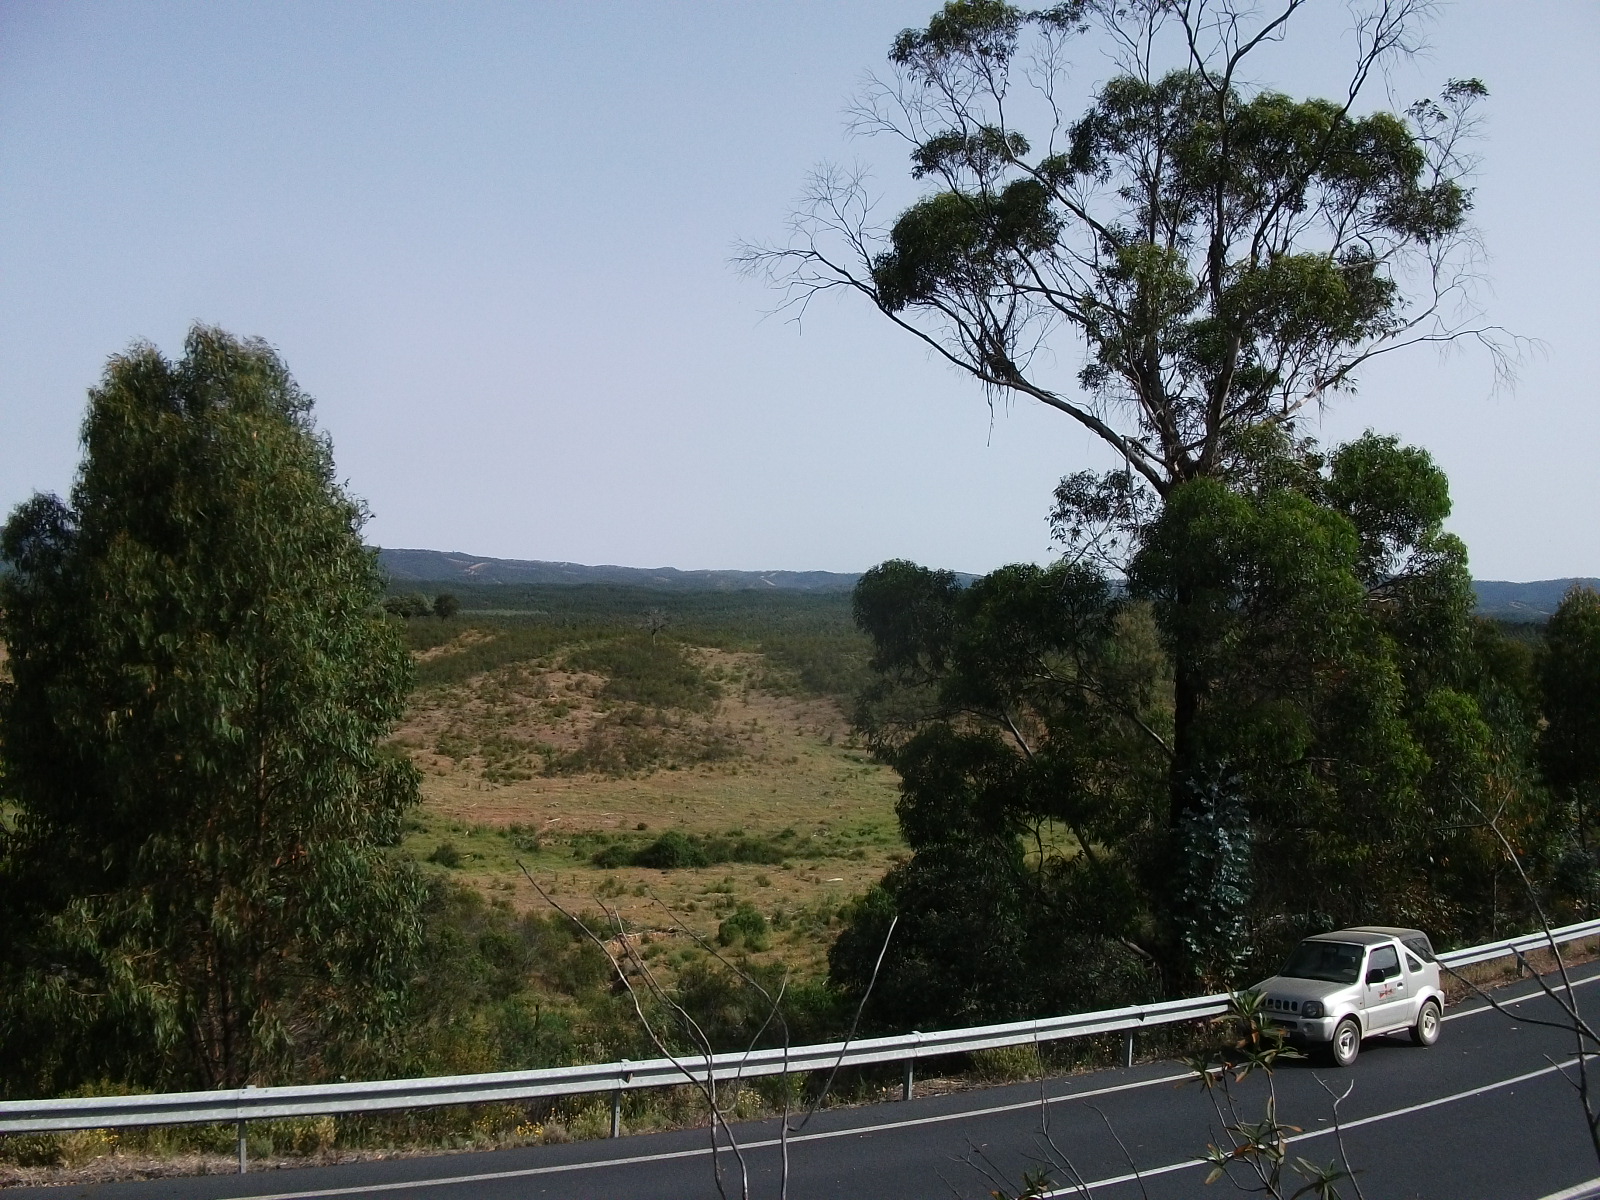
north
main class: Woodland
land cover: Broadleaved woodland
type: exotic forest
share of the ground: 25 - 50 %
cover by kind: shrubs 70 %, broadleaved forest trees 30 %
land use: Forestry
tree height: > 5 m
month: May
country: ES
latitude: 37.7709
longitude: -7.0223
